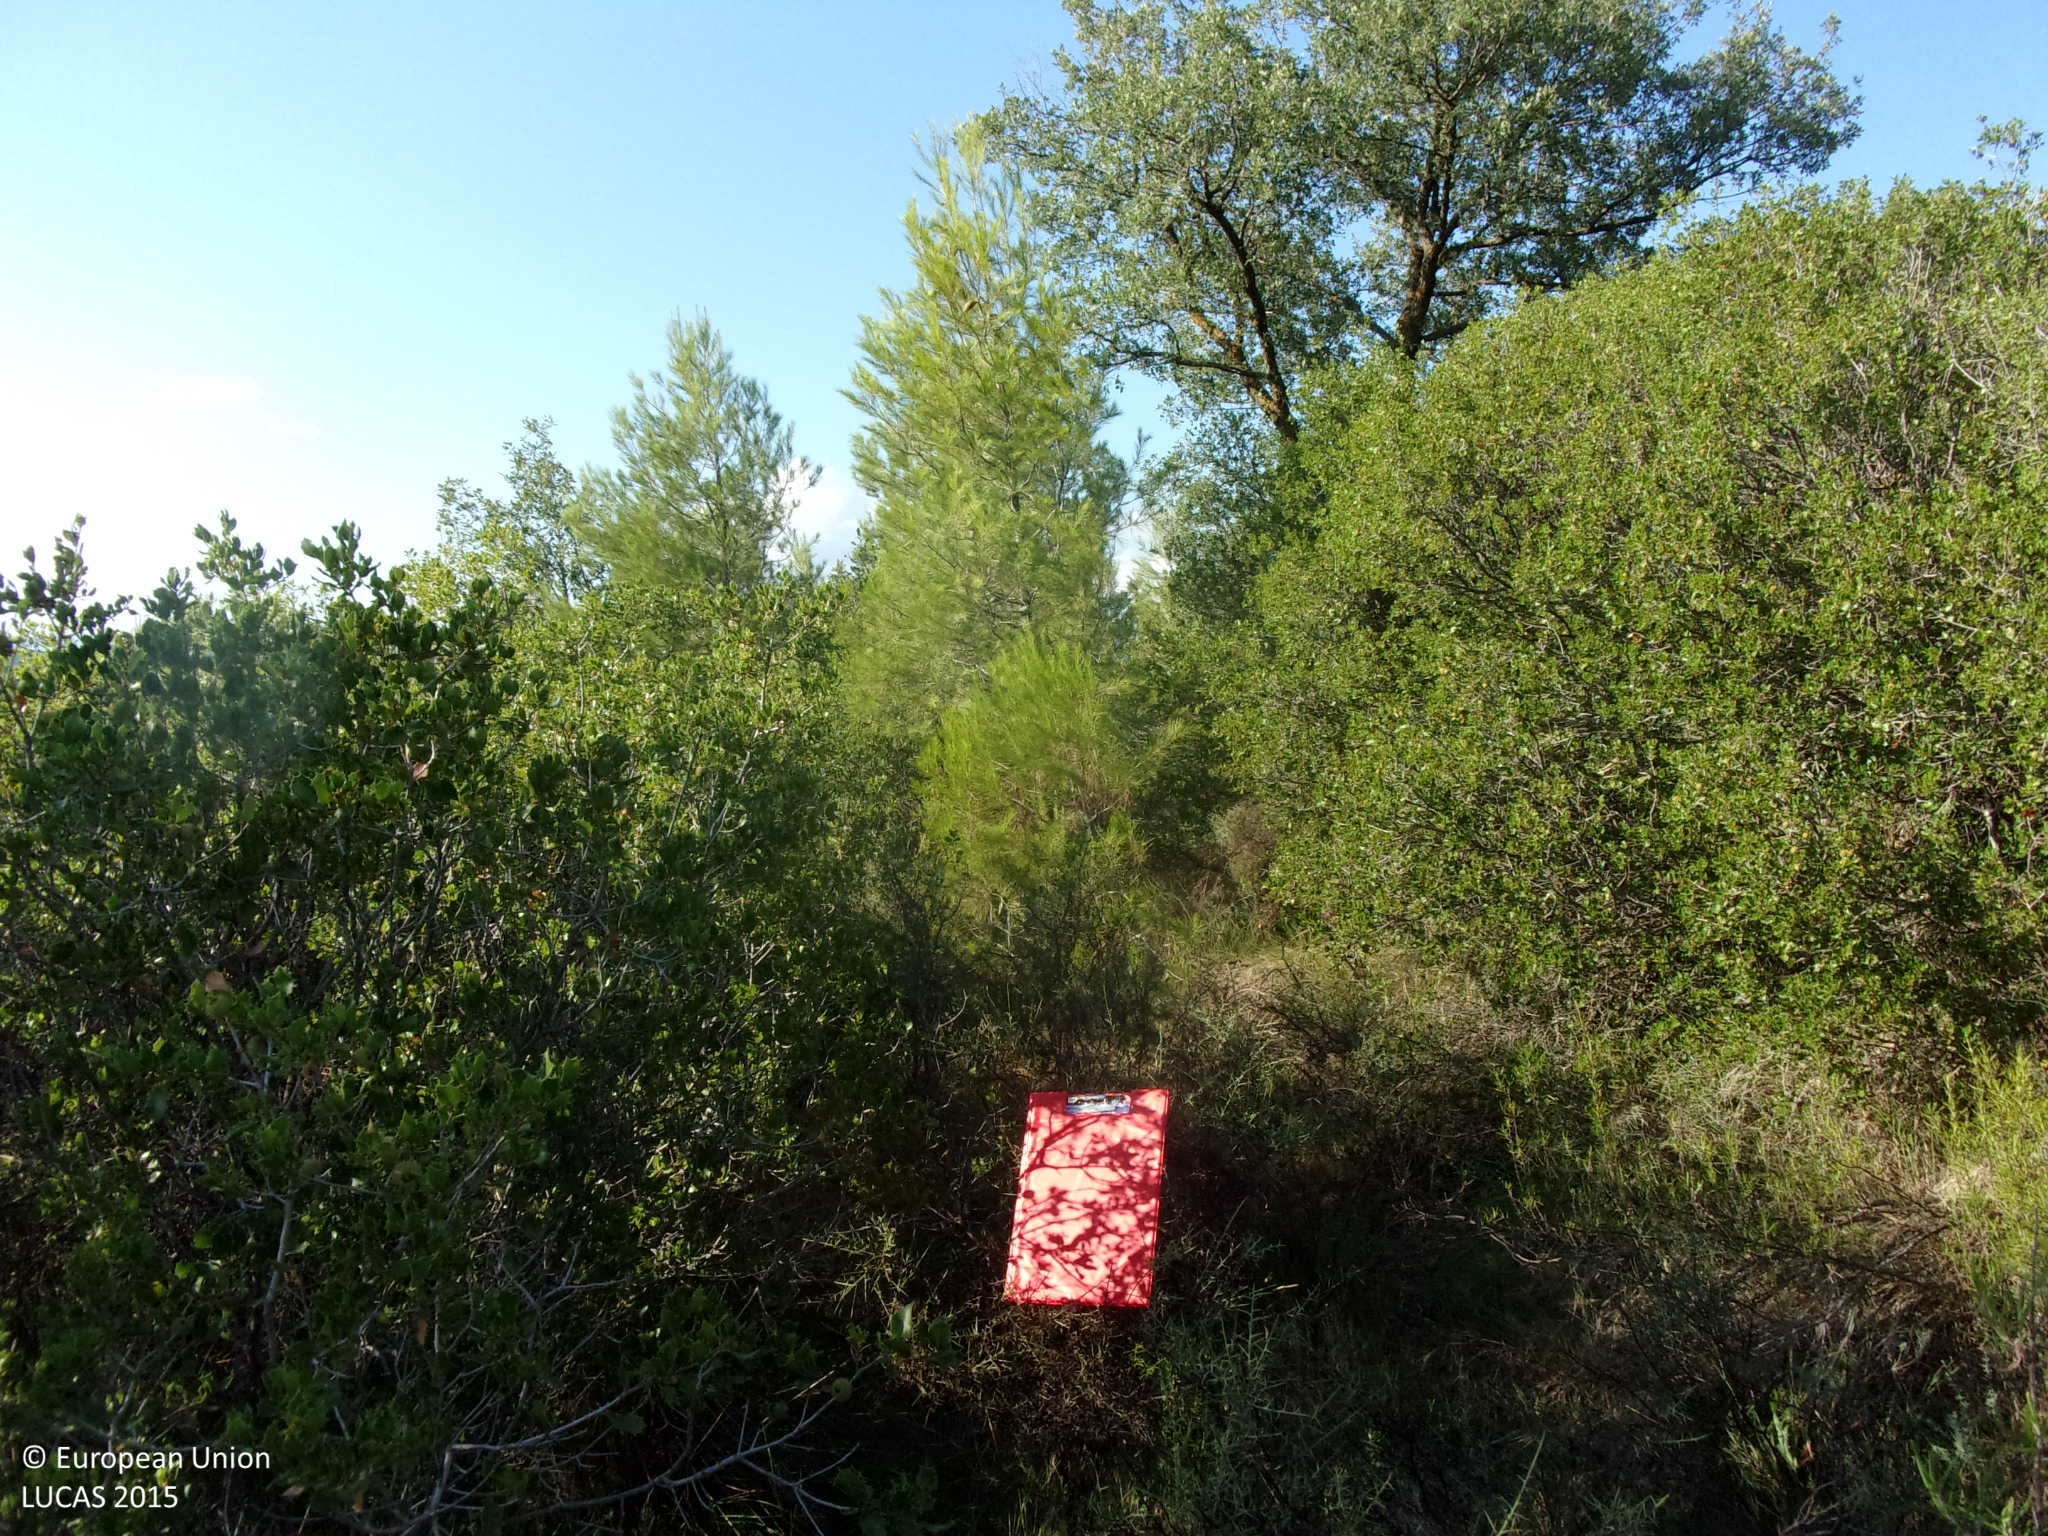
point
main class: Woodland
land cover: Pine dominated coniferous woodland
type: coniferous forest of the mediterranean region
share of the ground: 50 - 75 %
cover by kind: coniferous forest trees 60 %, shrubs 40 %
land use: Forestry
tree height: < 5 m
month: August
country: ES
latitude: 42.2284
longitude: -0.8953
